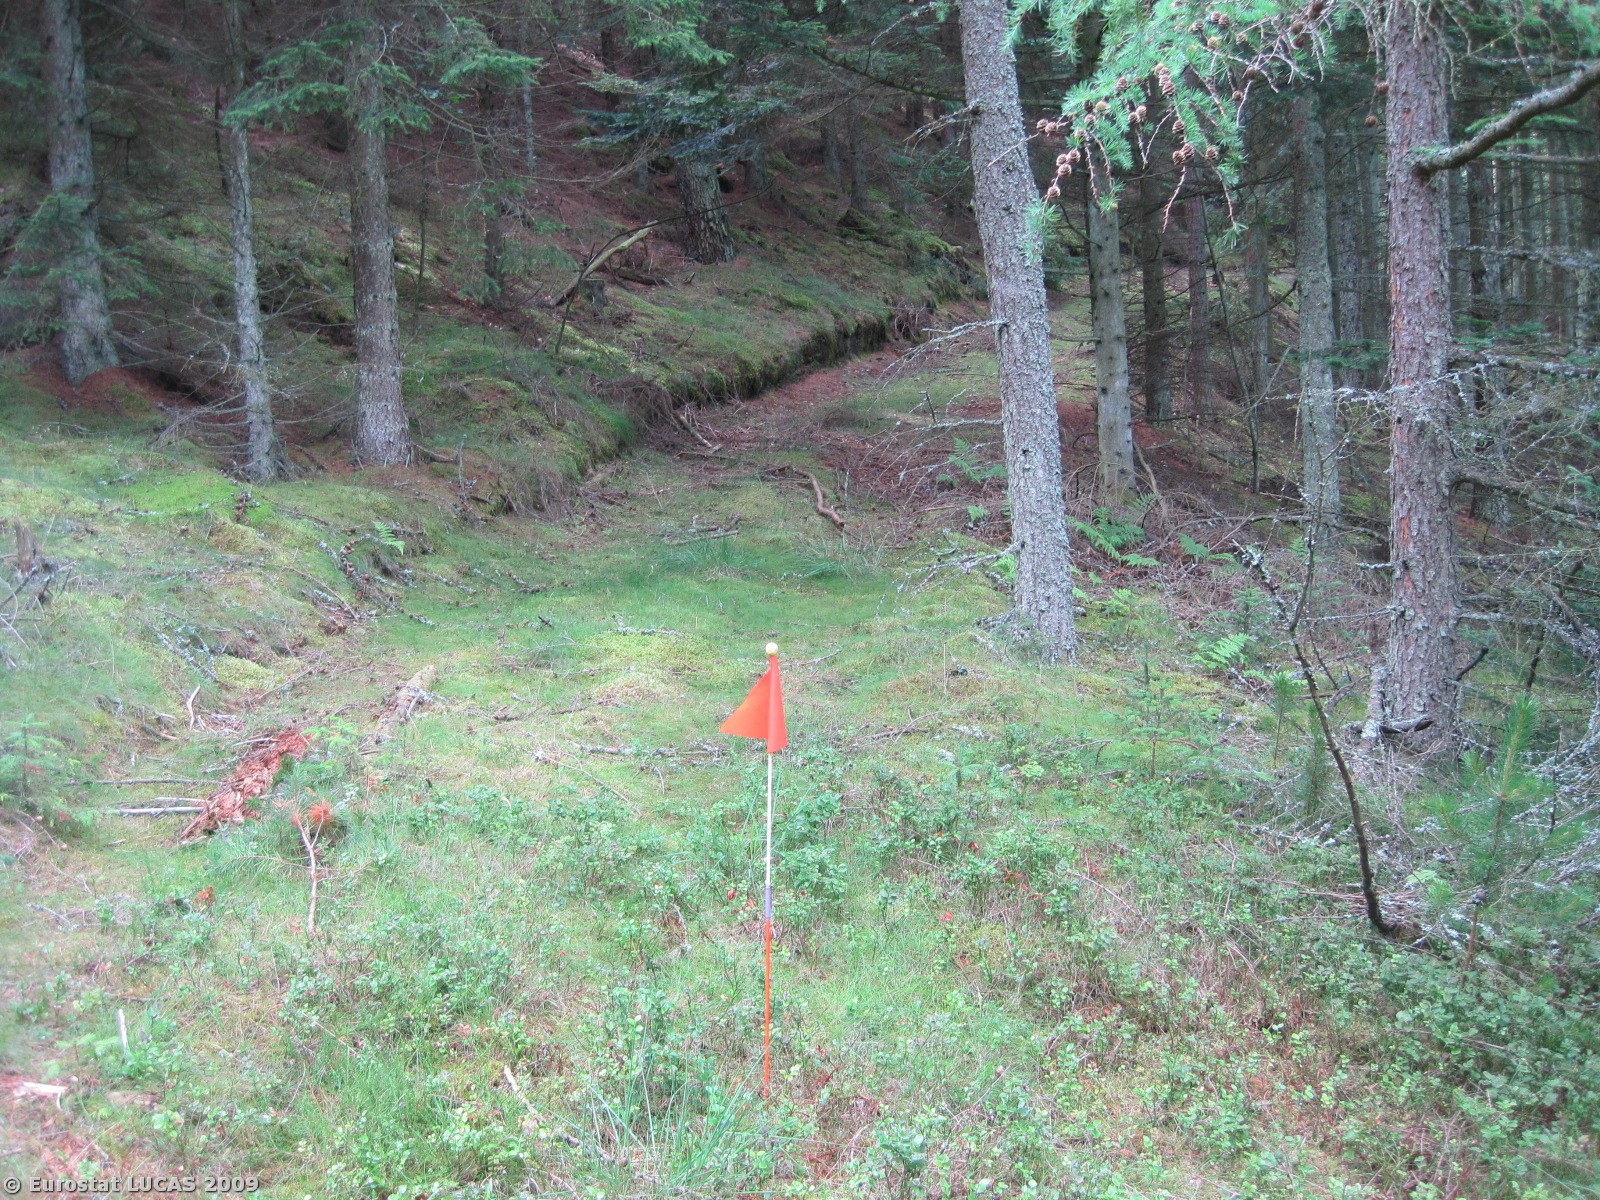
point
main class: Woodland
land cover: Coniferous woodland
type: plantations and self-sown exotic forest
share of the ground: 50 - 75 %
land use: Forestry
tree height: > 5 m
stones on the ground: < 10 %
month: July
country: DK
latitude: 57.0825
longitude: 8.9621
